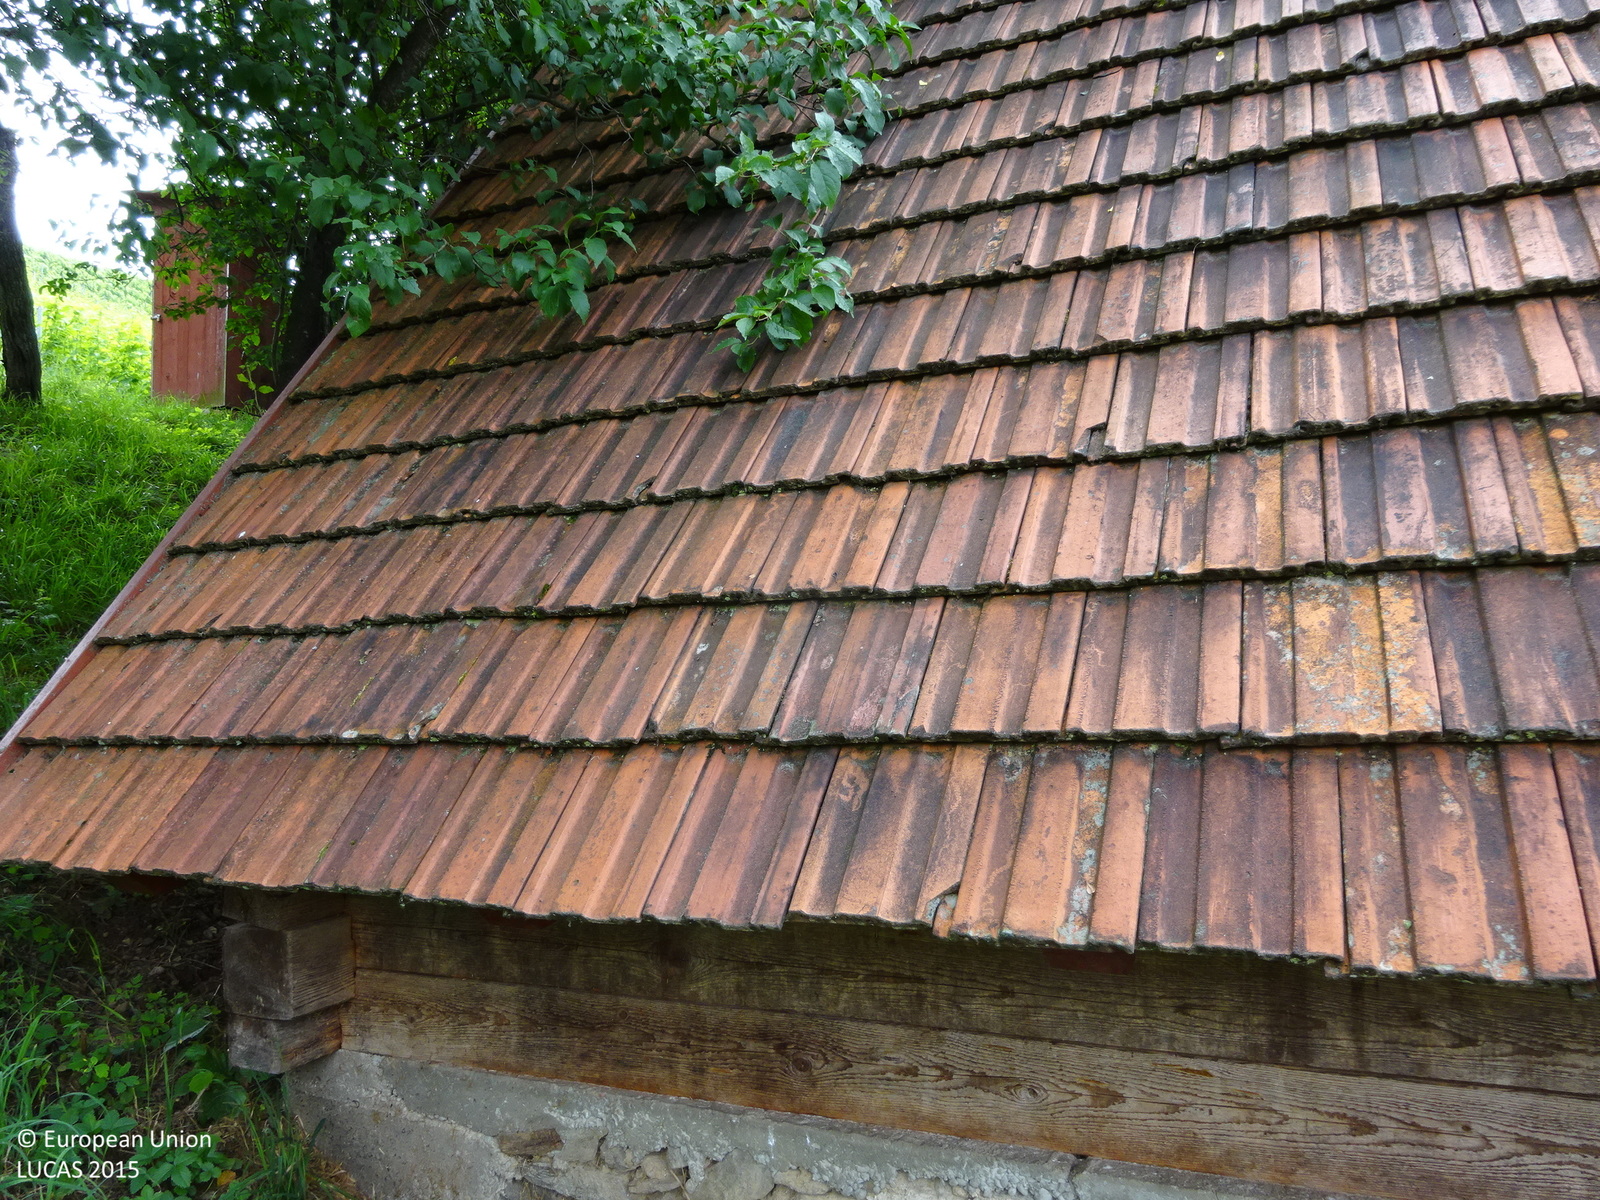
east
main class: Cropland
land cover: Apple fruit
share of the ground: 25 - 50 %
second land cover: Grassland without tree/shrub cover
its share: > 75 %
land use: Kitchen garden
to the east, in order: Apple fruit; Grassland without tree/shrub cover; Artificial constructions in urban areas; Vineyards; Grassland without tree/shrub cover; Electric lines; Grassland without tree/shrub cover; Vineyards; Grassland without tree/shrub cover; Other fibre and oleaginous crops; Paved roads, cycling and walking lanes; Grass margins; Grassland without tree/shrub cover; Vineyards
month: June
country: AT
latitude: 46.7726
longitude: 15.4339
